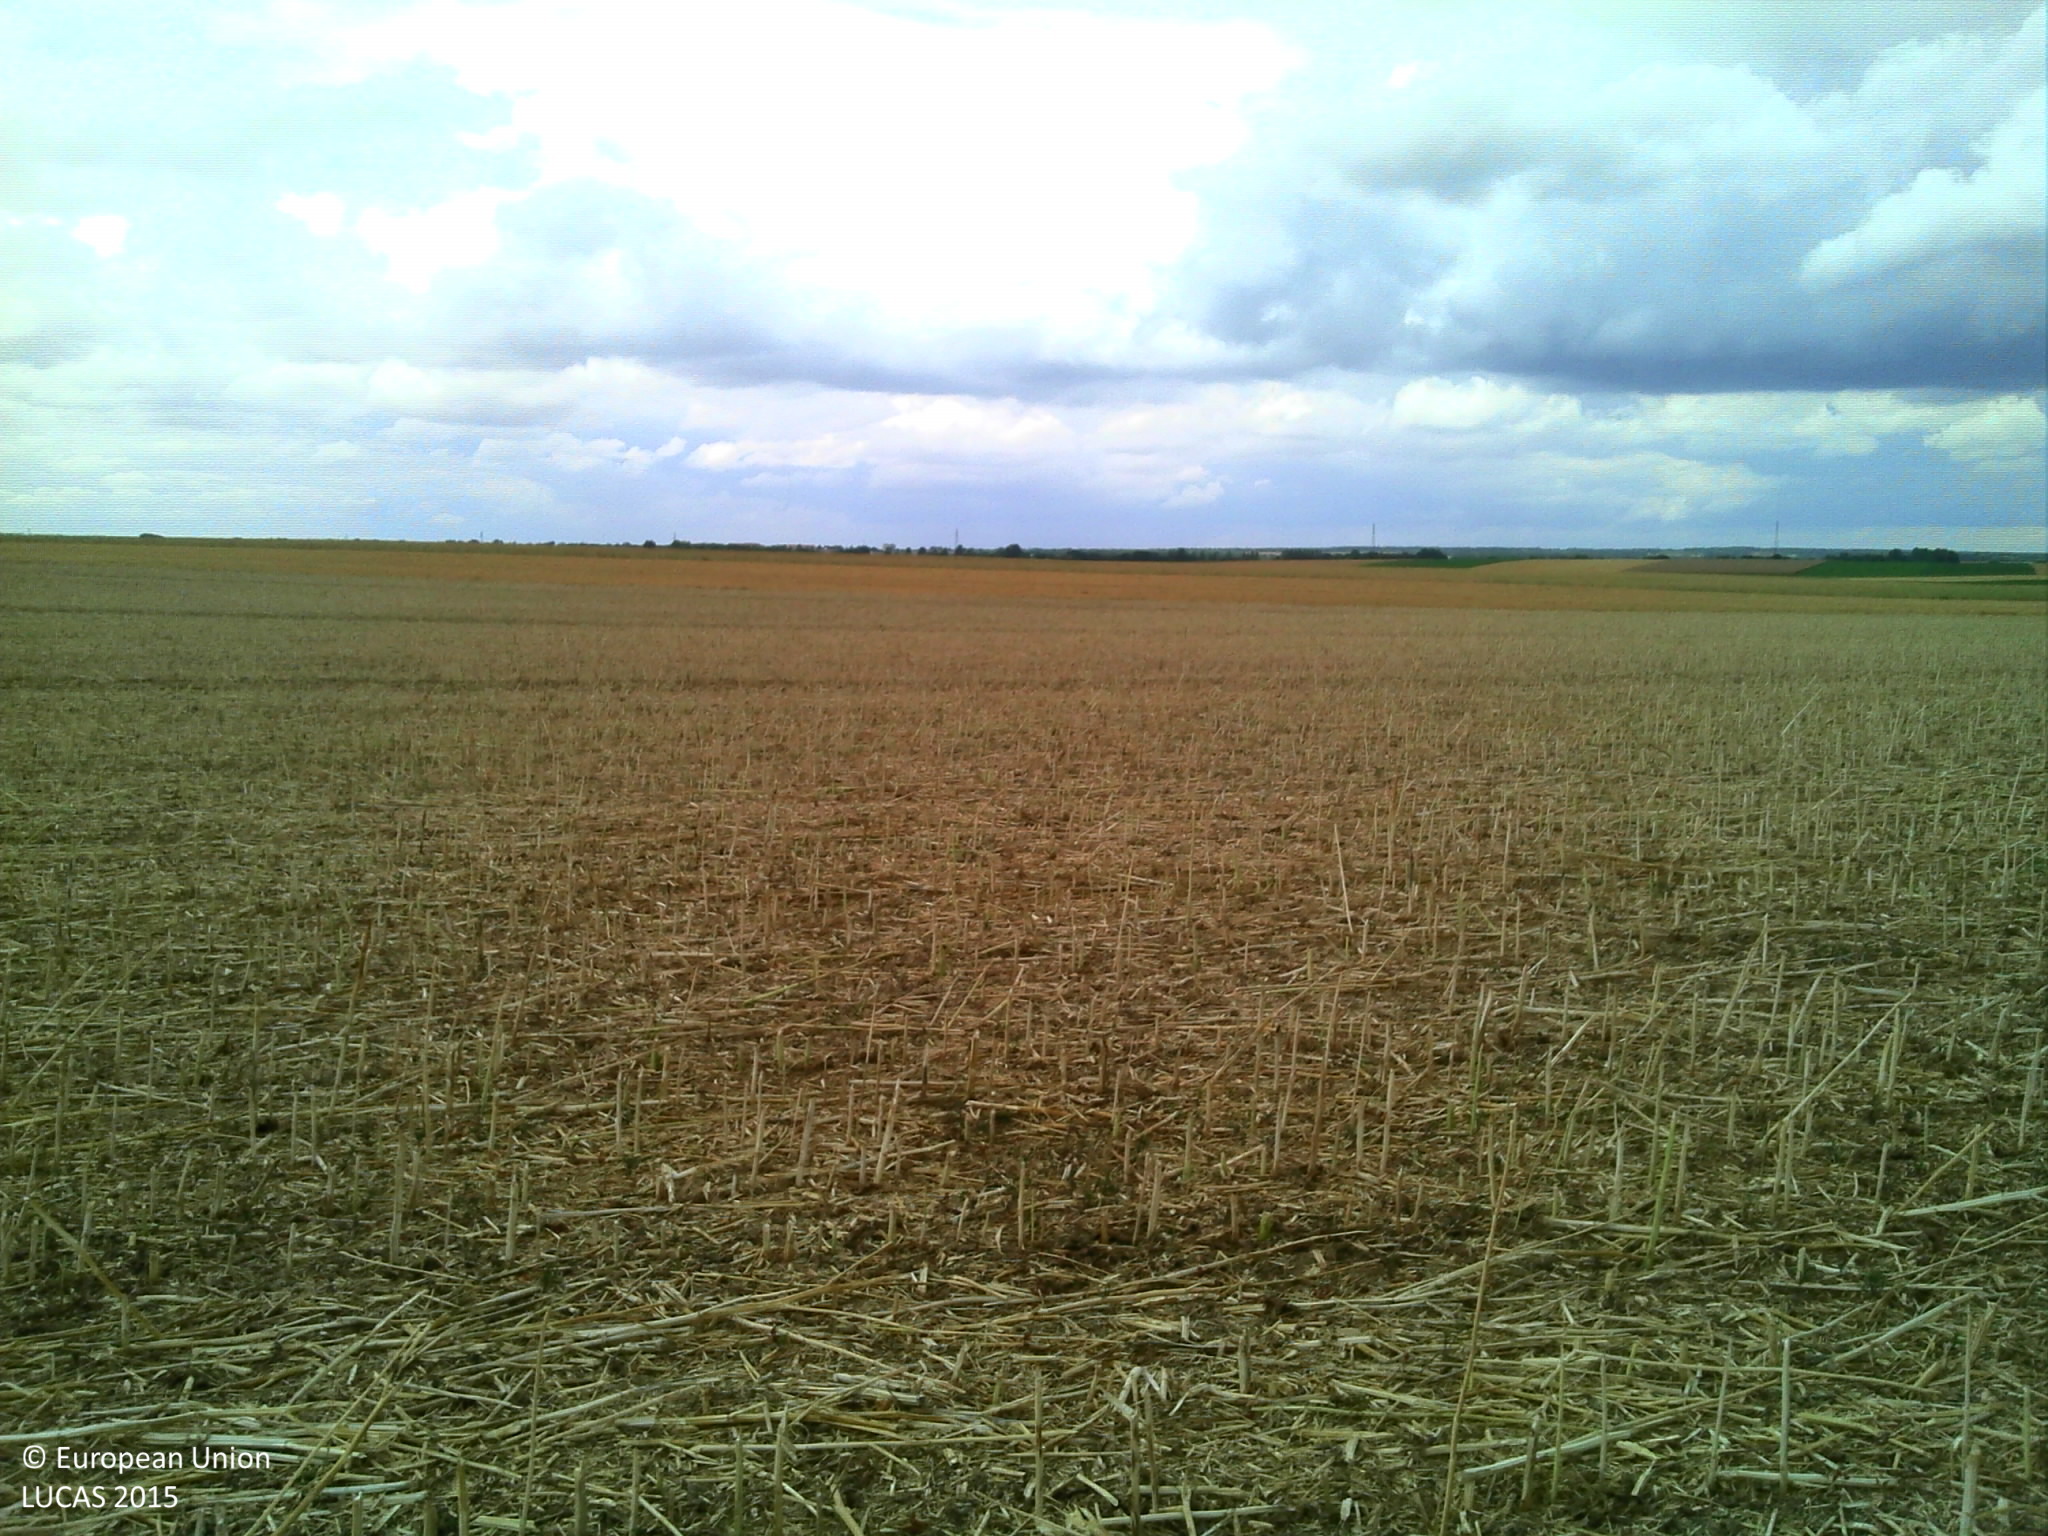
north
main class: Cropland
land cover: Rape and turnip rape
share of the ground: > 75 %
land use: Agriculture (excluding fallow land and kitchen gardens)
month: July
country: FR
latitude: 49.0990
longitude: 4.5594
